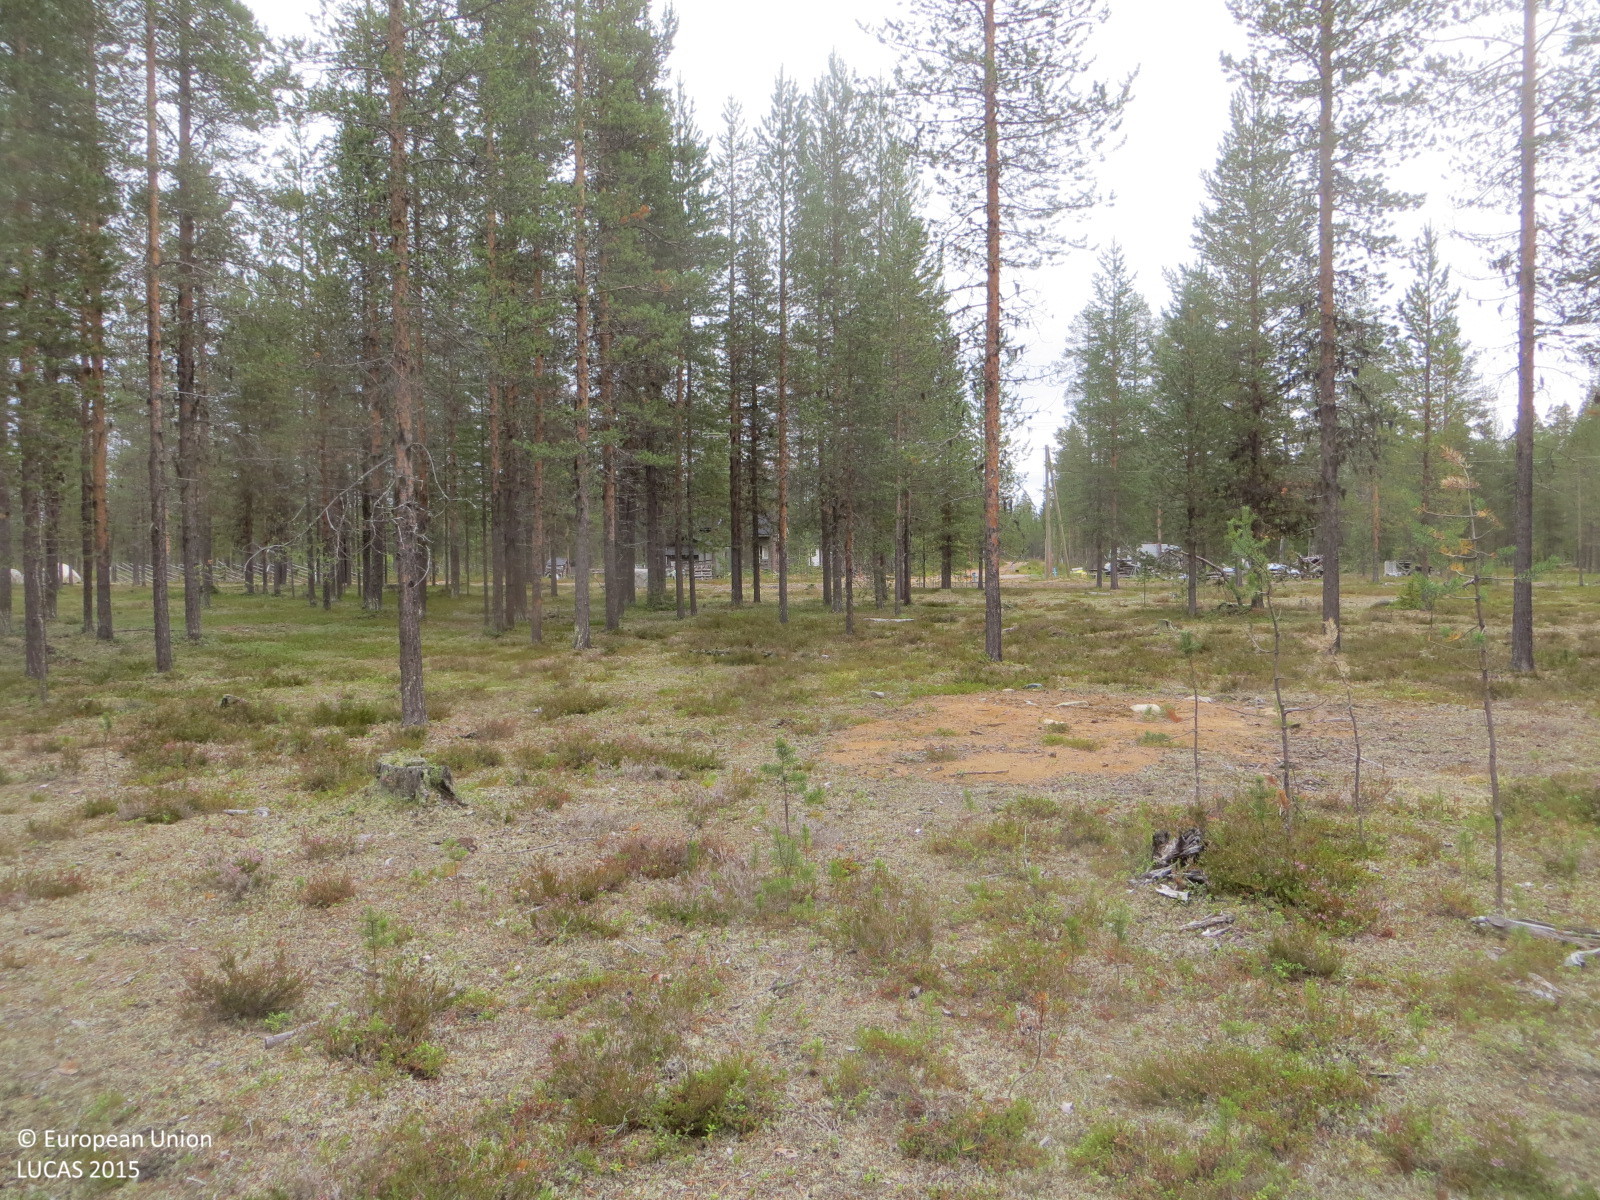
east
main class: Woodland
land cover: Pine dominated coniferous woodland
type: boreal forest
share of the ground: 25 - 50 %
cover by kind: shrubs 55 %, coniferous forest trees 45 %
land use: Forestry
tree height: > 5 m
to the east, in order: Pine dominated coniferous woodland; Tracks; Grassland with sparse tree/shrub cover; Artificial constructions in urban areas; Pine dominated coniferous woodland; Artificial constructions in urban areas; Pine dominated coniferous woodland
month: August
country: FI
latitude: 67.4588
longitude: 24.2634
